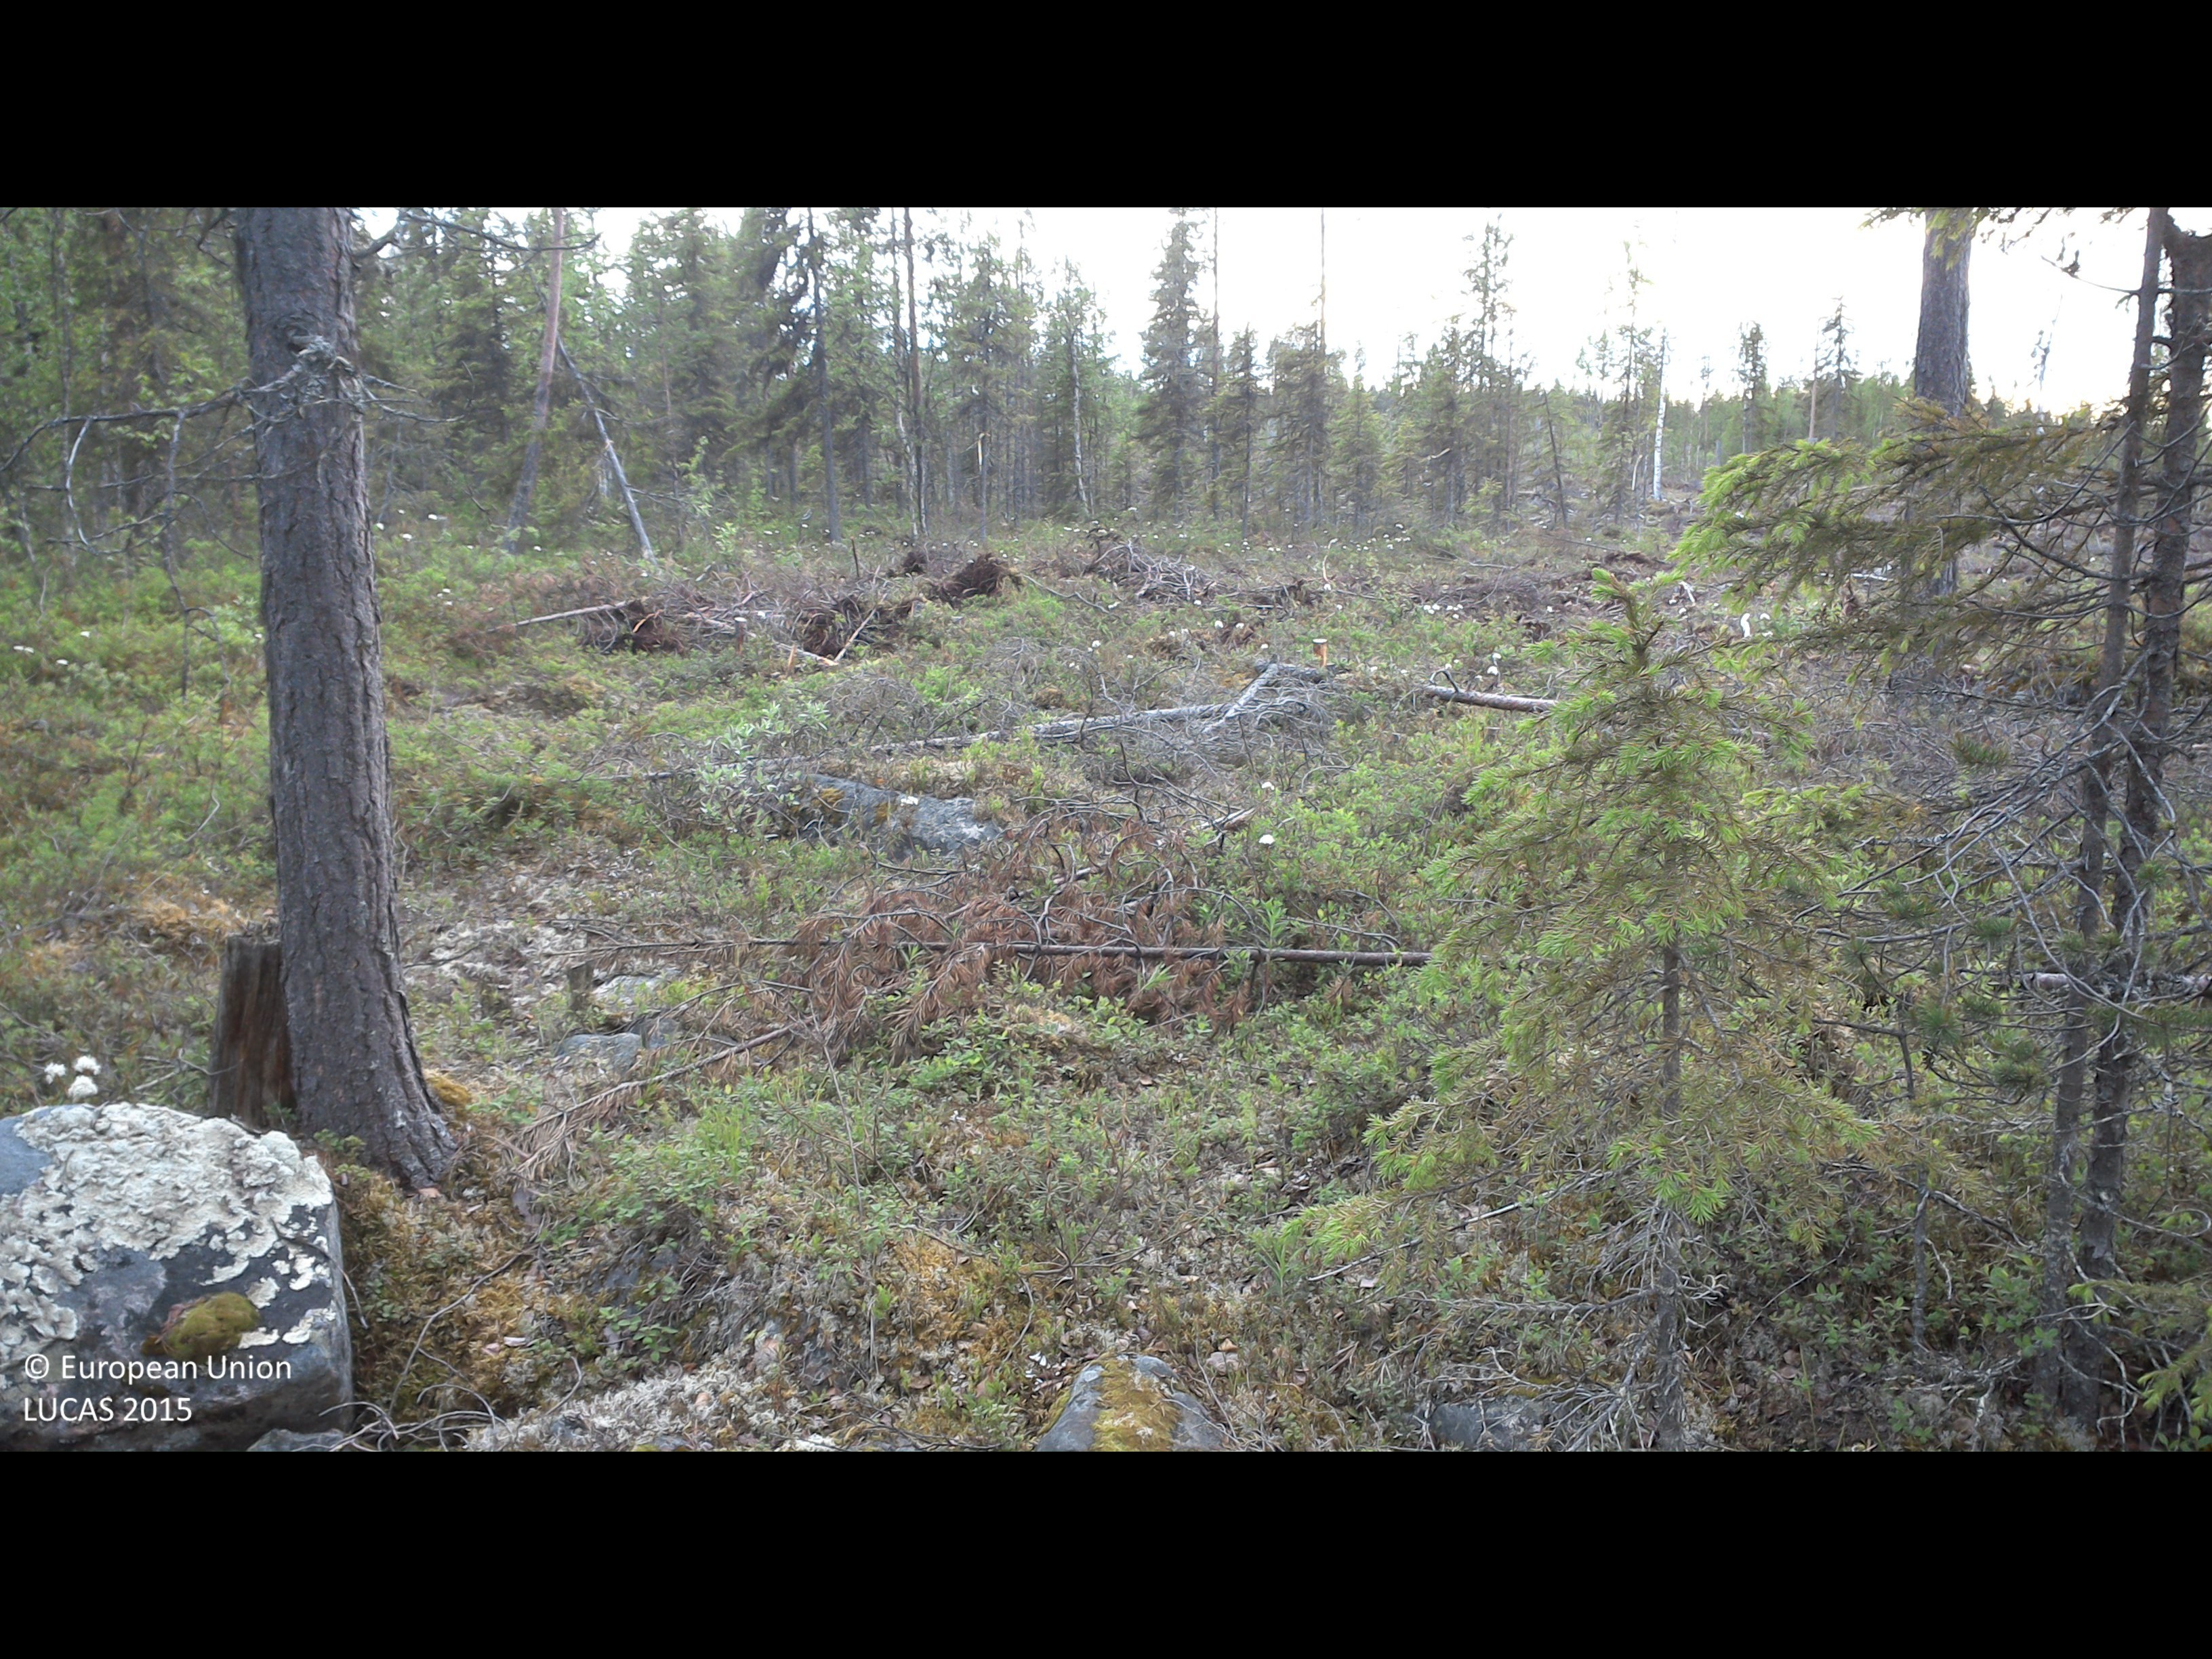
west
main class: Woodland
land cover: Spruce dominated coniferous woodland
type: boreal forest
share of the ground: > 75 %
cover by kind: shrubs 55 %, lichens and mosses 20 %, coniferous forest trees 15 %, broadleaved forest trees 5 %, unconsolidated bare surface 5 %
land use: Forestry
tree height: > 5 m
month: June
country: SE
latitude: 66.9165
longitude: 22.6991
